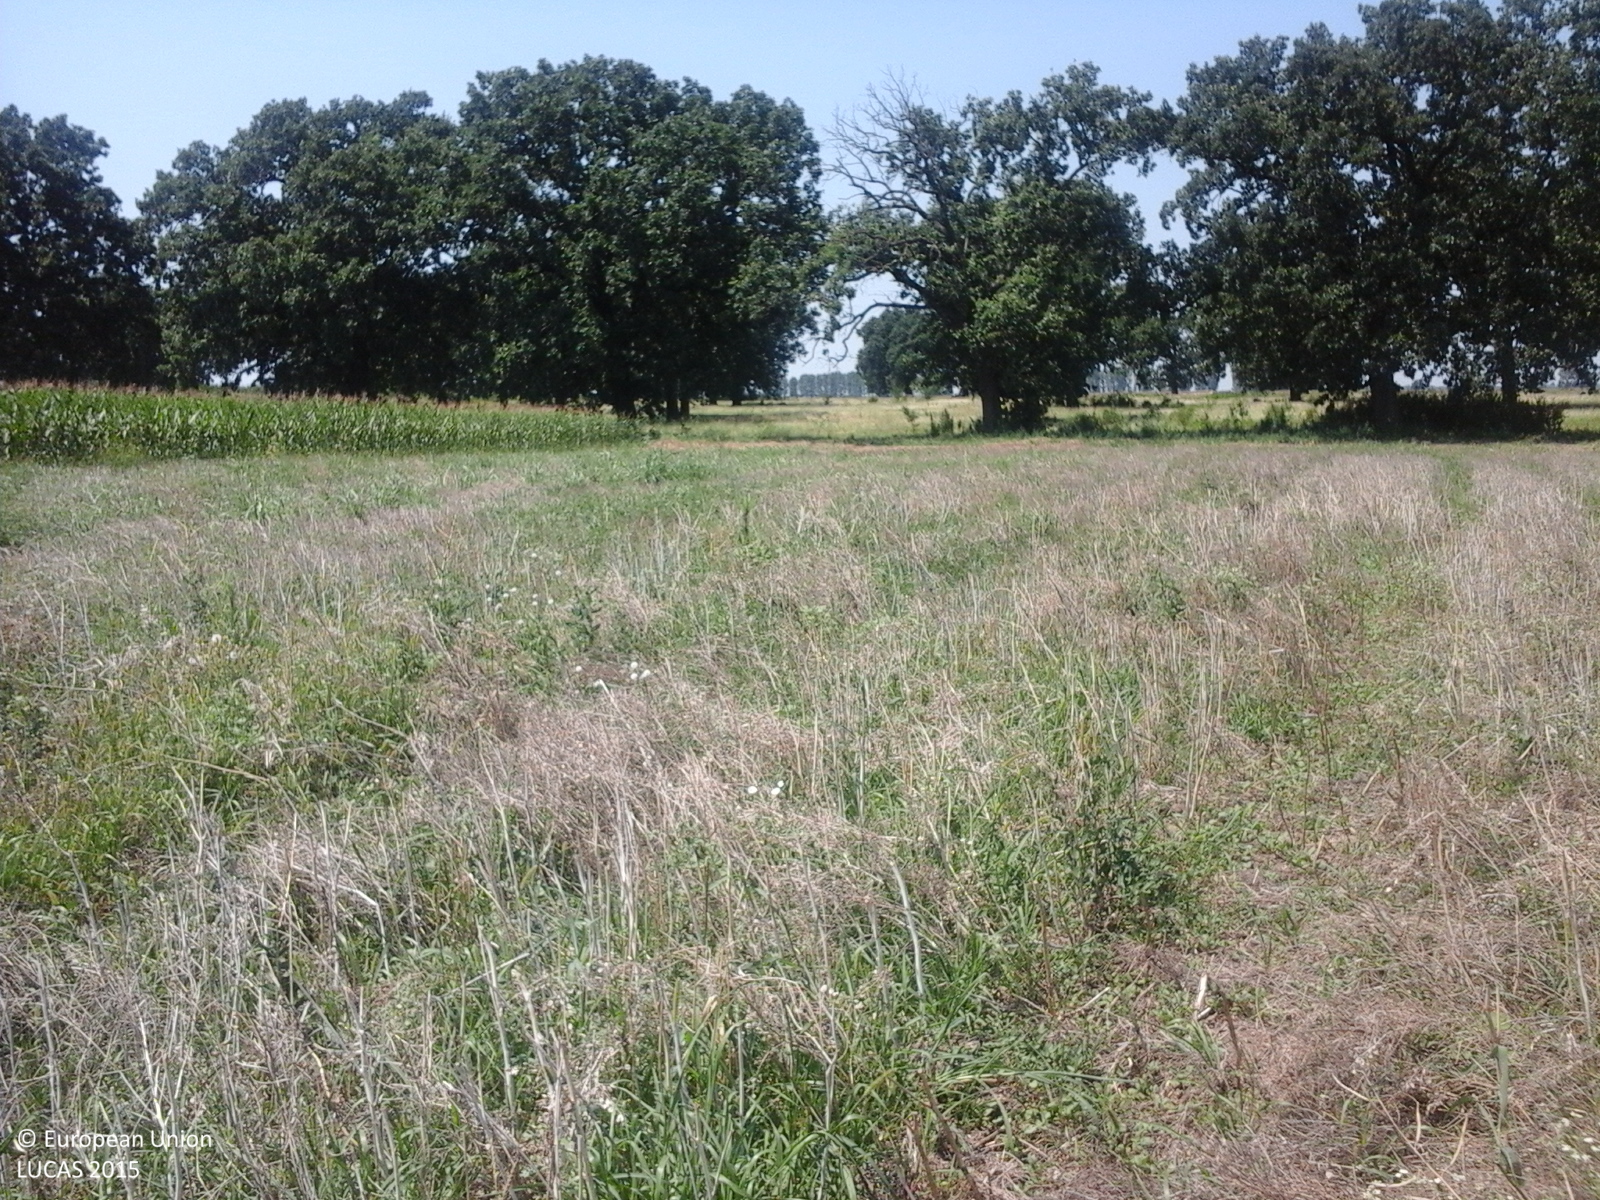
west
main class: Cropland
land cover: Rape and turnip rape
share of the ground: > 75 %
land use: Agriculture (excluding fallow land and kitchen gardens)
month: July
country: RO
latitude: 44.7063
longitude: 26.7468
